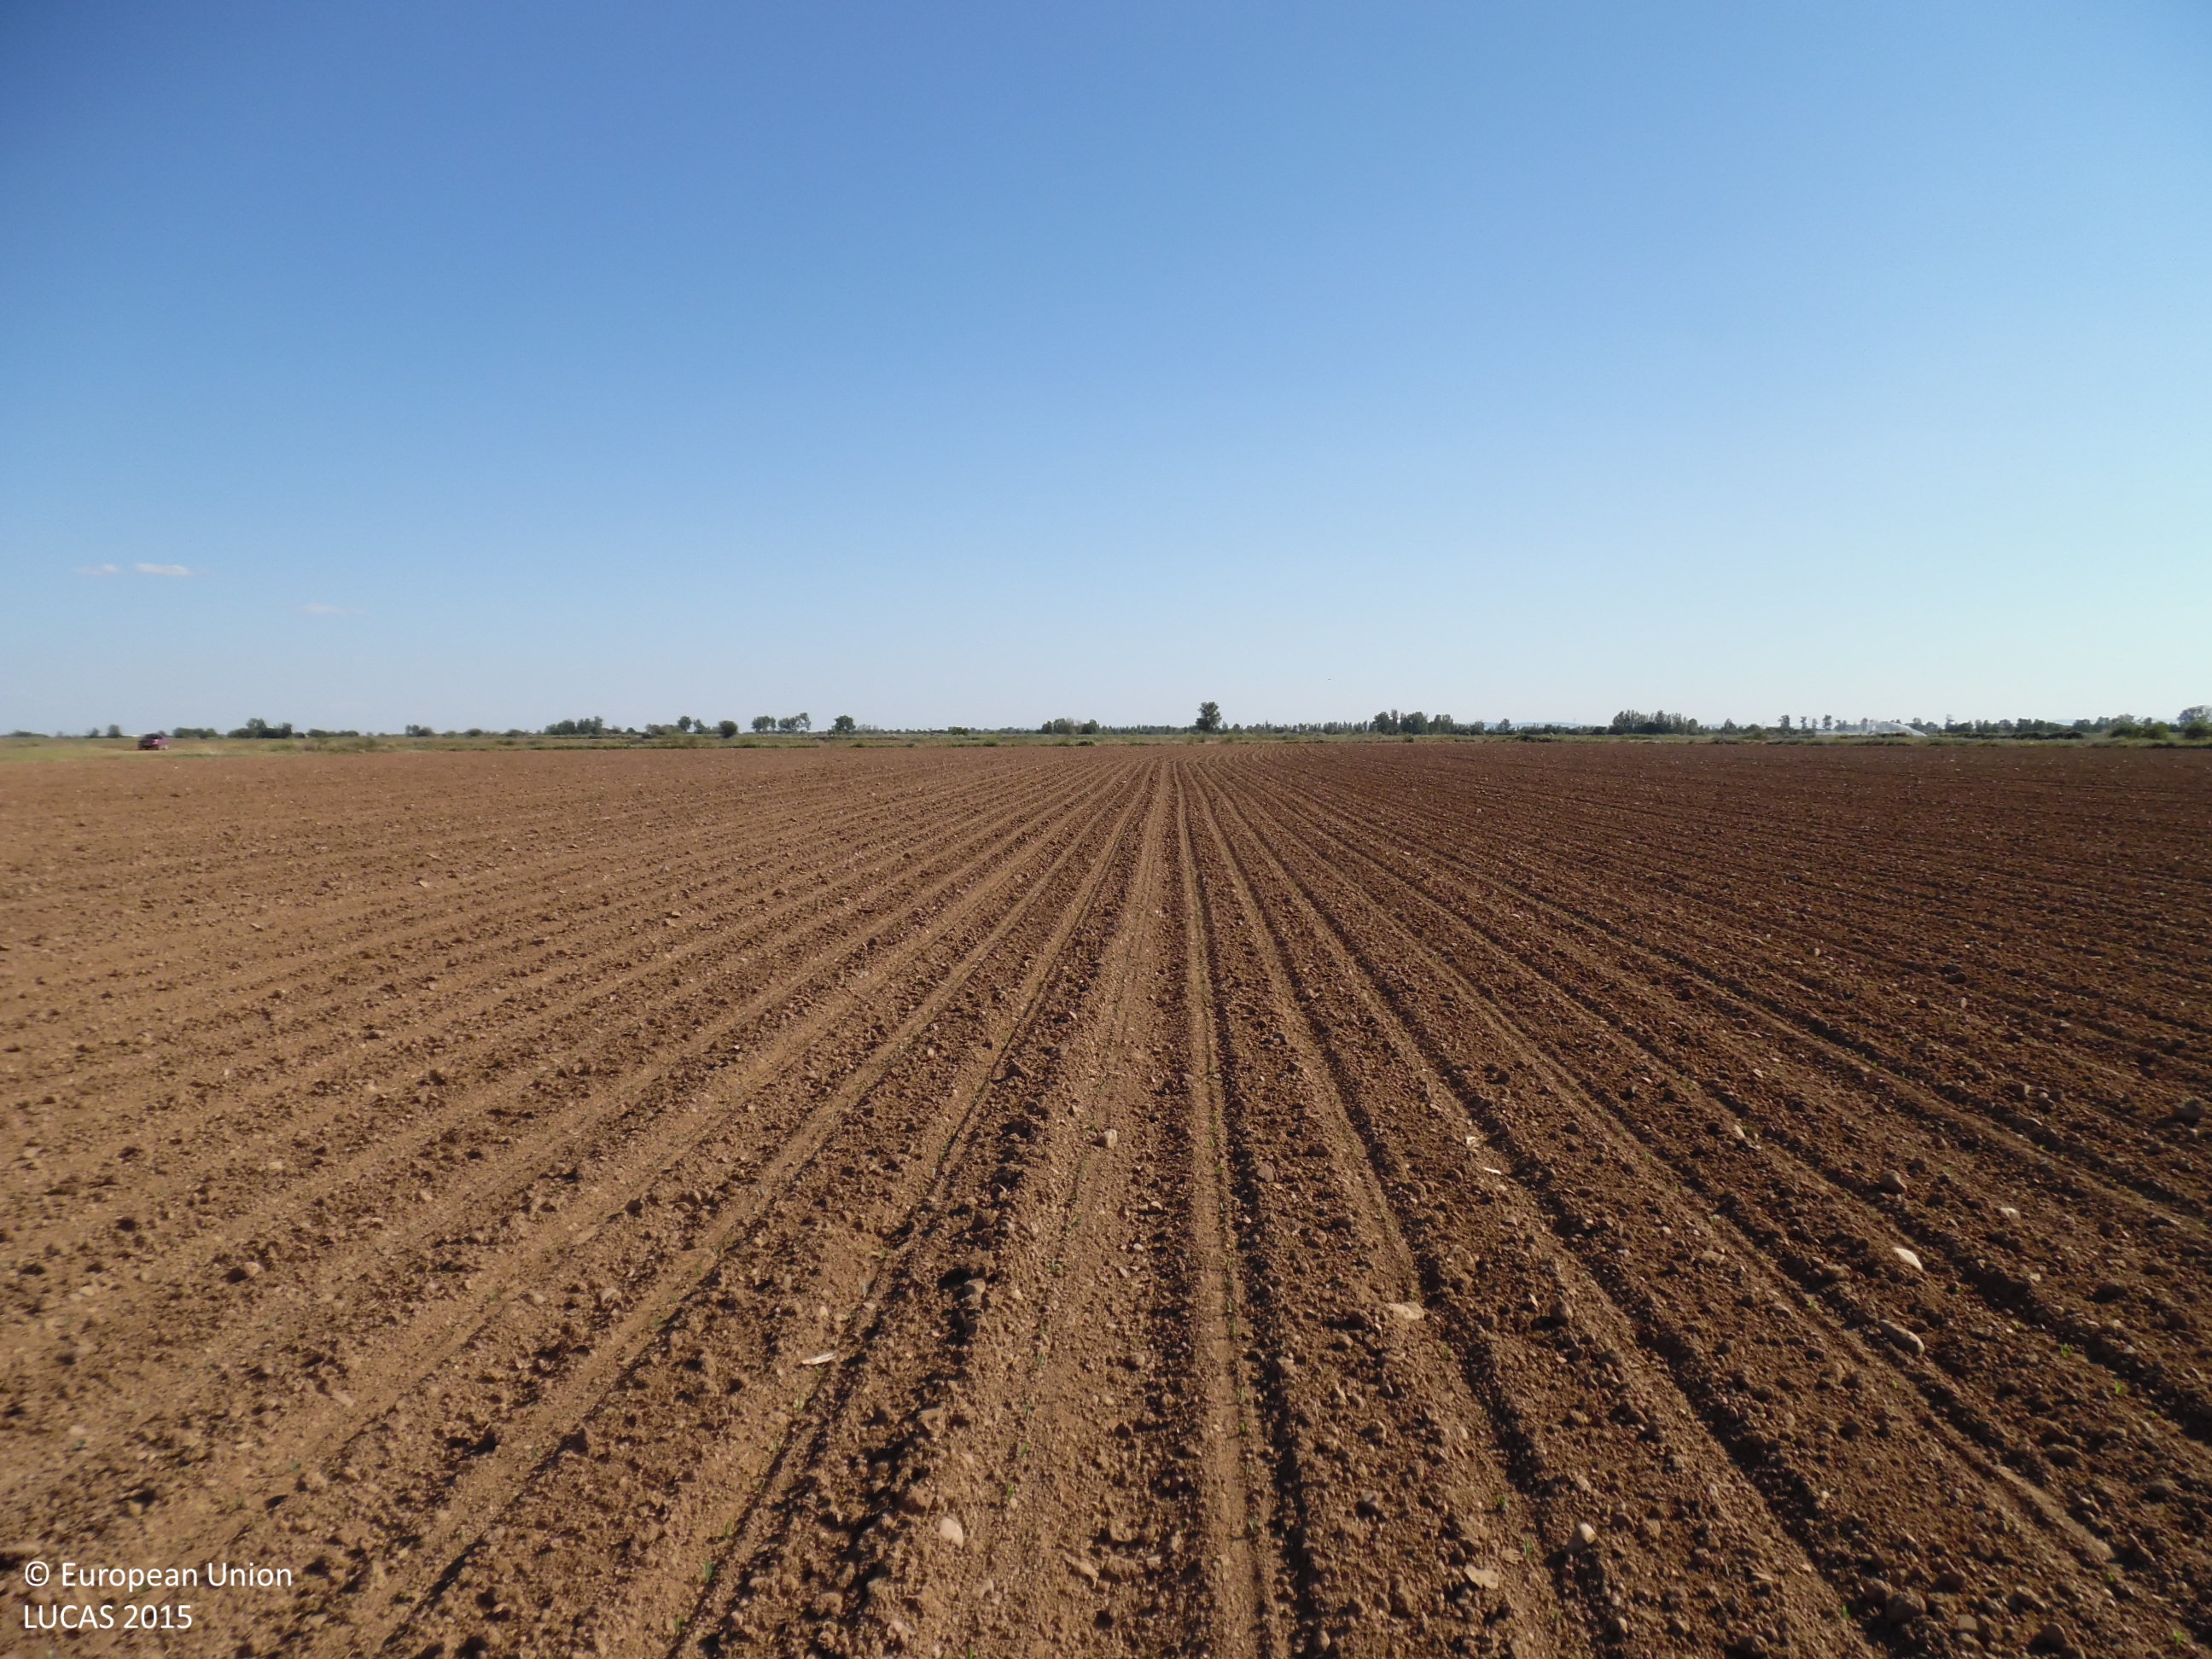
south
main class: Cropland
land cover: Maize
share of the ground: < 10 %
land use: Agriculture (excluding fallow land and kitchen gardens)
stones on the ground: 10 - 25 %
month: June
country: ES
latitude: 42.4595
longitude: -5.7500
